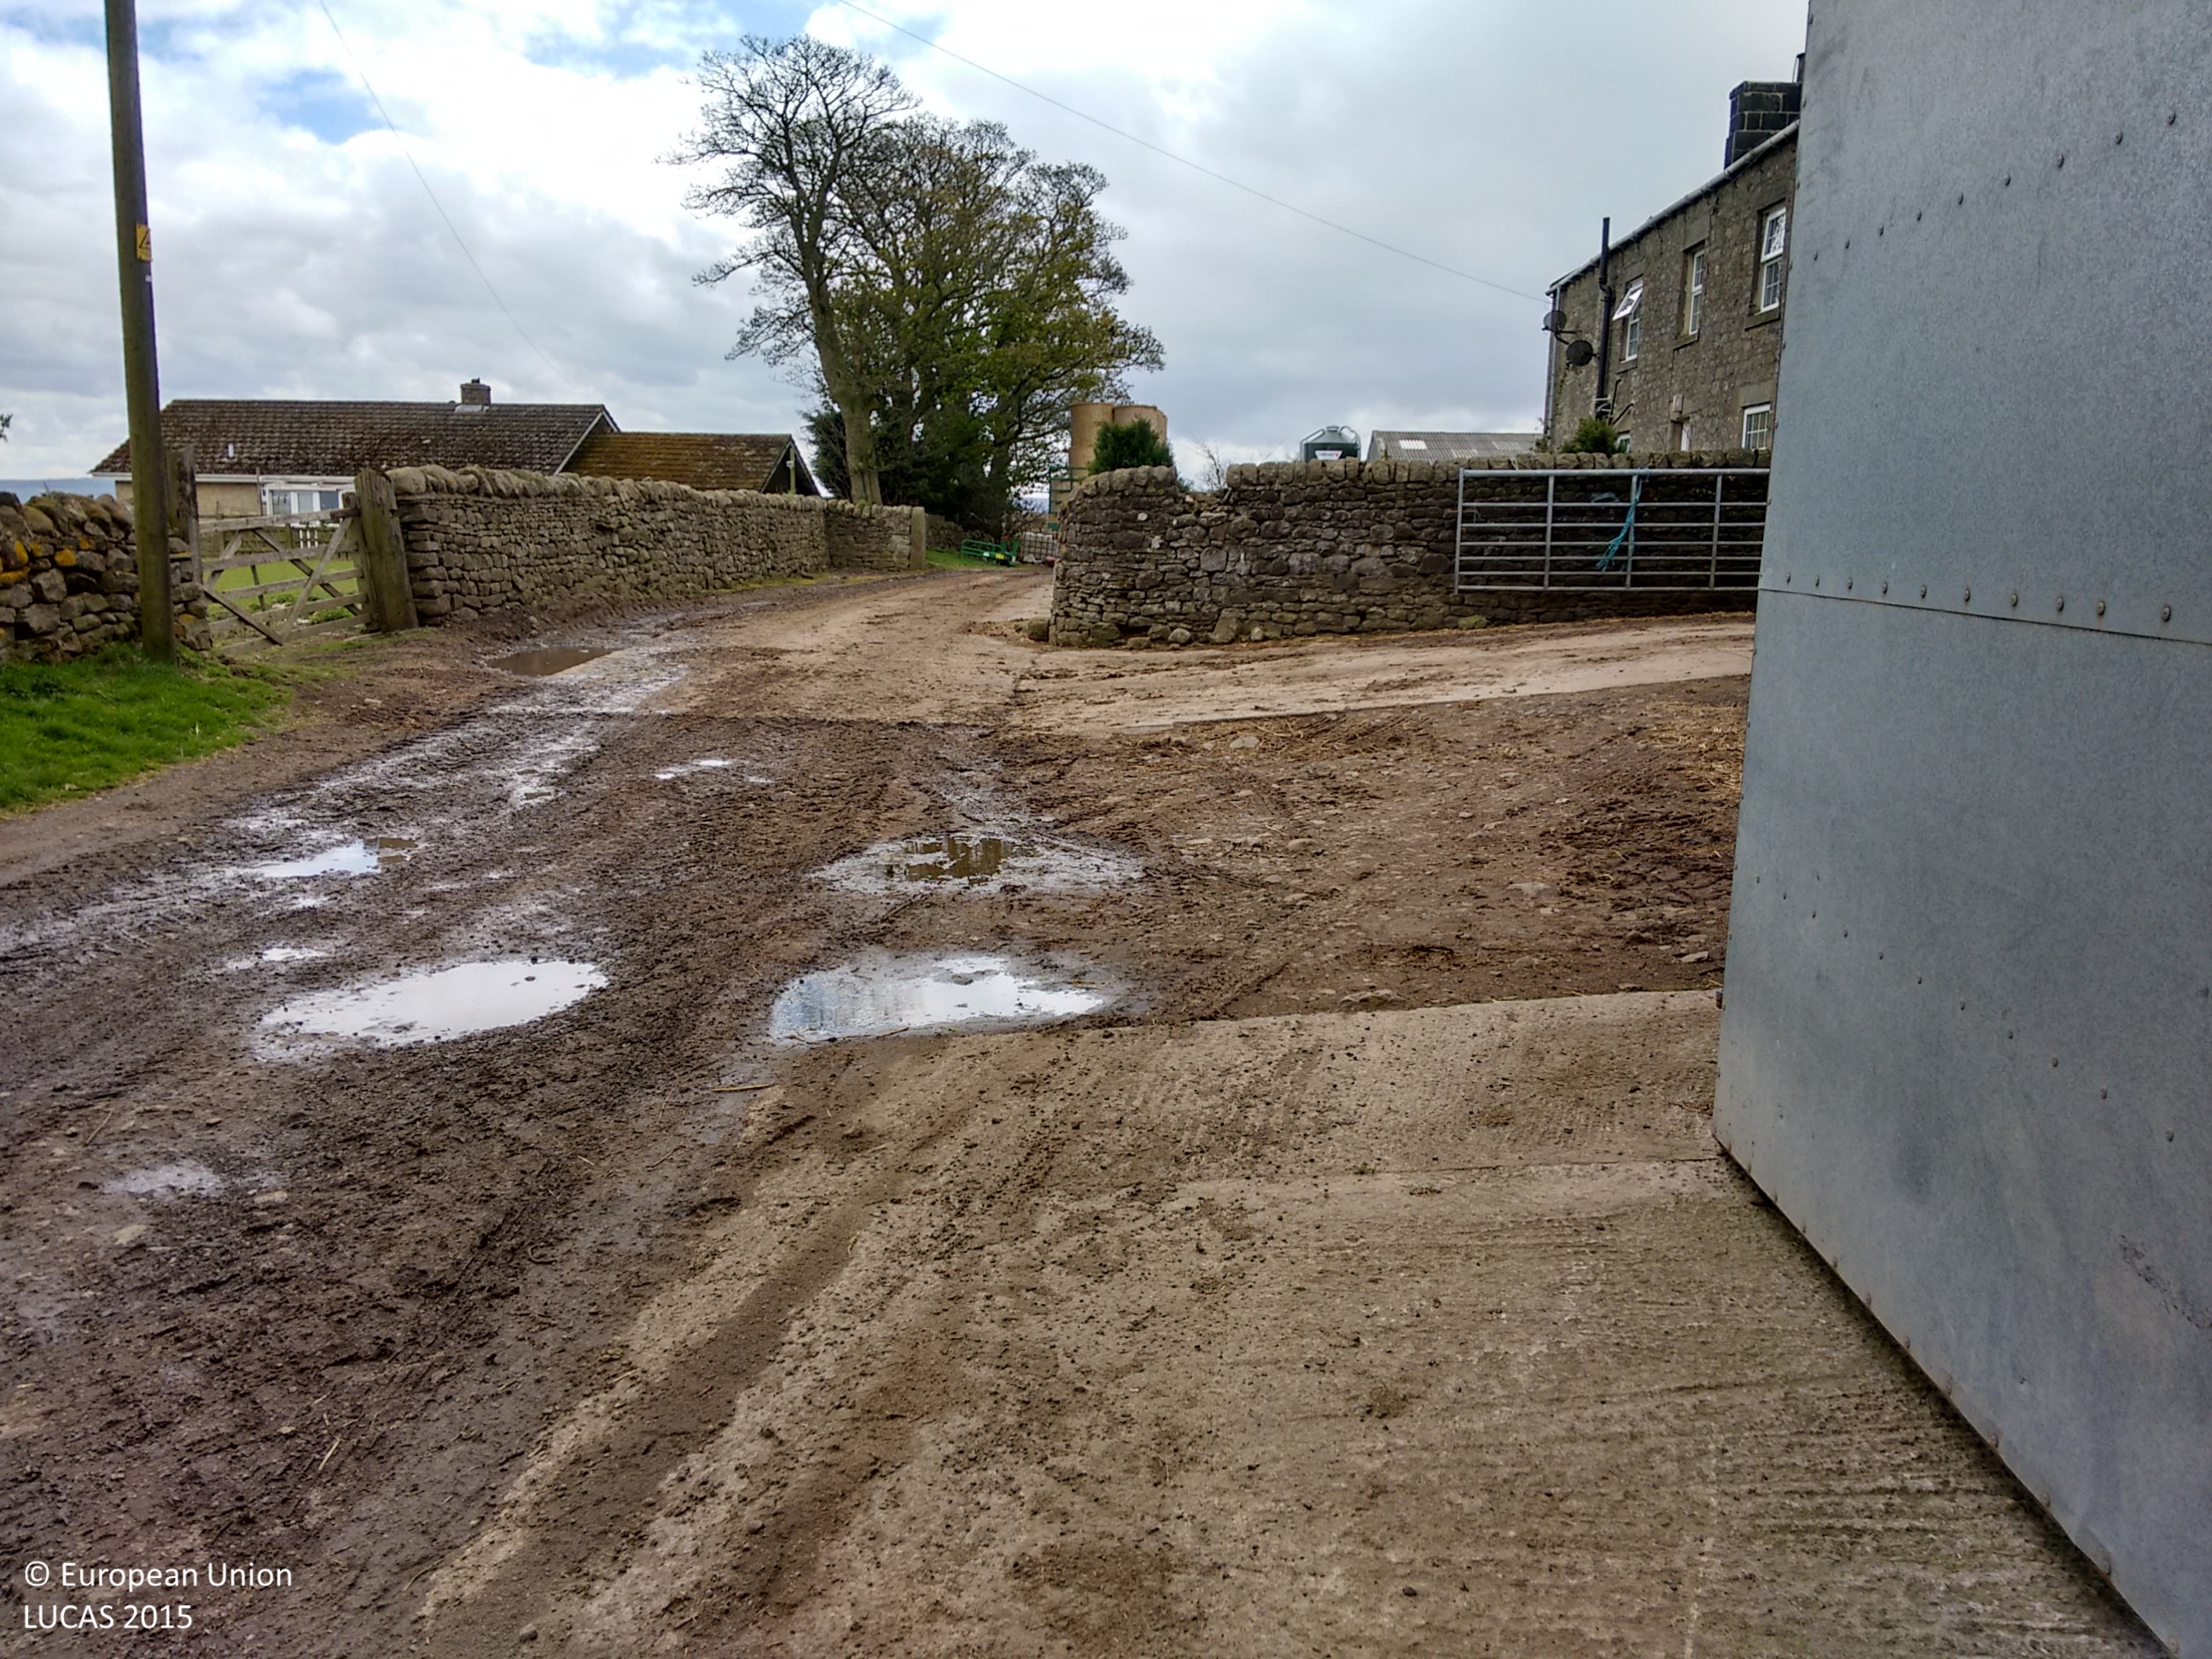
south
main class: Grassland
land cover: Grassland without tree/shrub cover
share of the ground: > 75 %
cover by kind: herbaceous plants 100 %
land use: Agriculture (excluding fallow land and kitchen gardens)
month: May
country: GB
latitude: 54.9517
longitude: -2.1582
